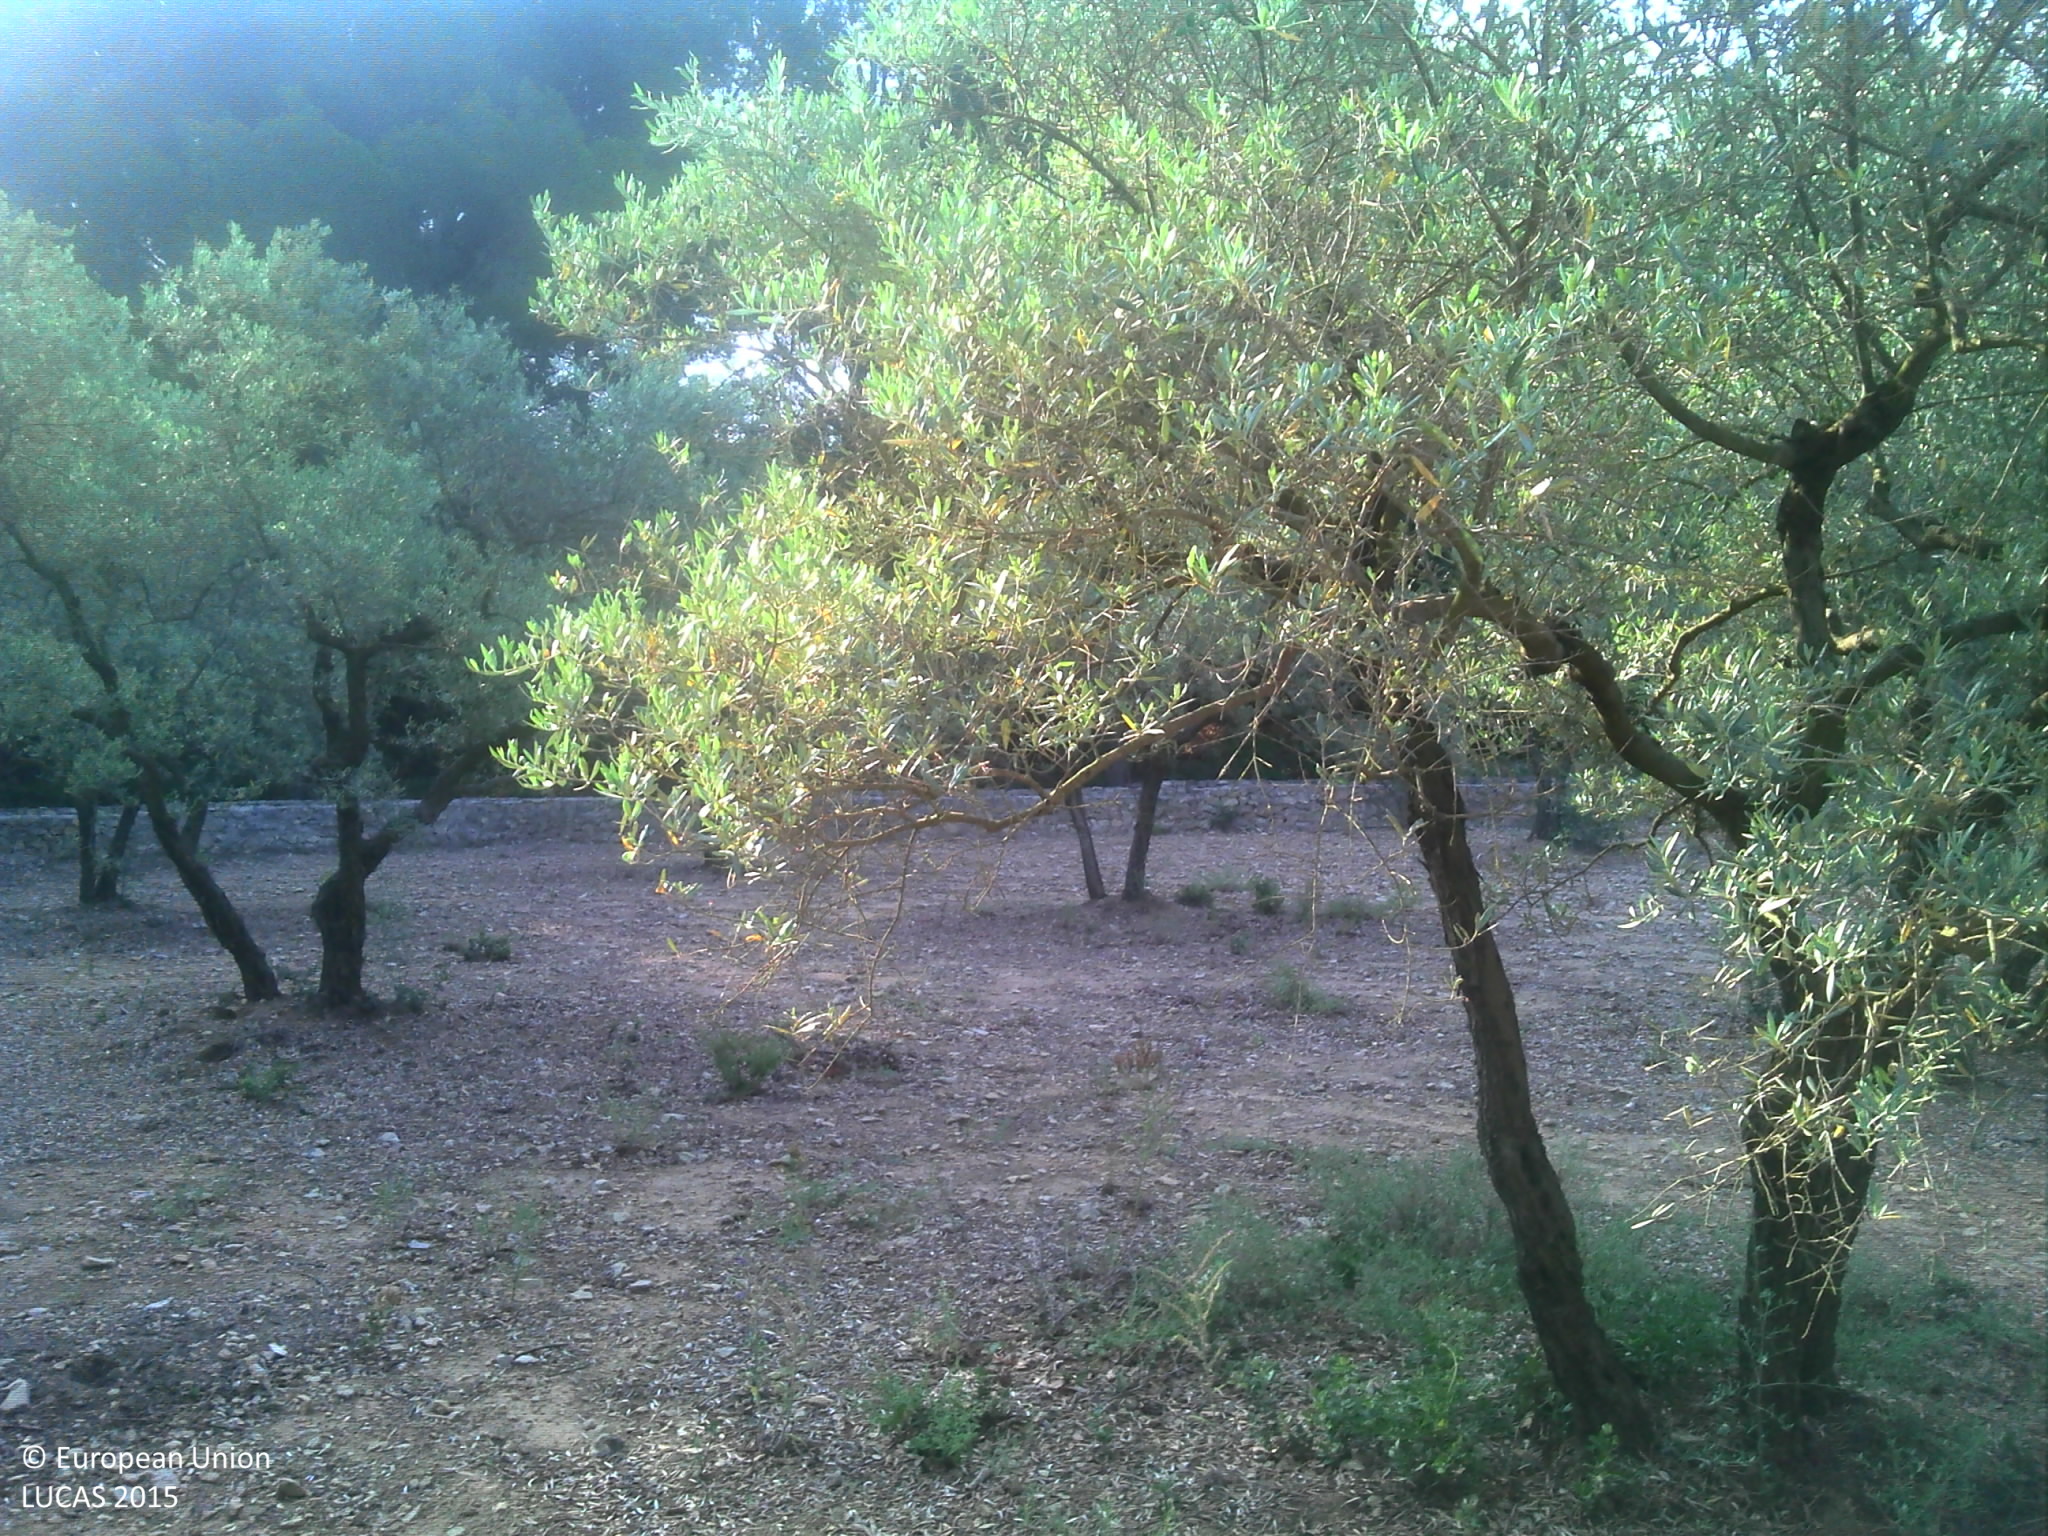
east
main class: Cropland
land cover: Olive groves
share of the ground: 10 - 25 %
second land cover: Other bare soil
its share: > 75 %
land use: Agriculture (excluding fallow land and kitchen gardens)
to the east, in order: Olive groves; Other bare soil; Electric lines; Olive groves; Artificial constructions; Tracks; Dry stone walls; Pine dominated coniferous woodland; Pine dominated mixed woodland; Artificial constructions; Olive groves; Grass margins; Tracks; Grass margins; Fences; Spontaneously vegetated surfaces; Olive groves
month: July
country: FR
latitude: 43.6043
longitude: 5.1408
